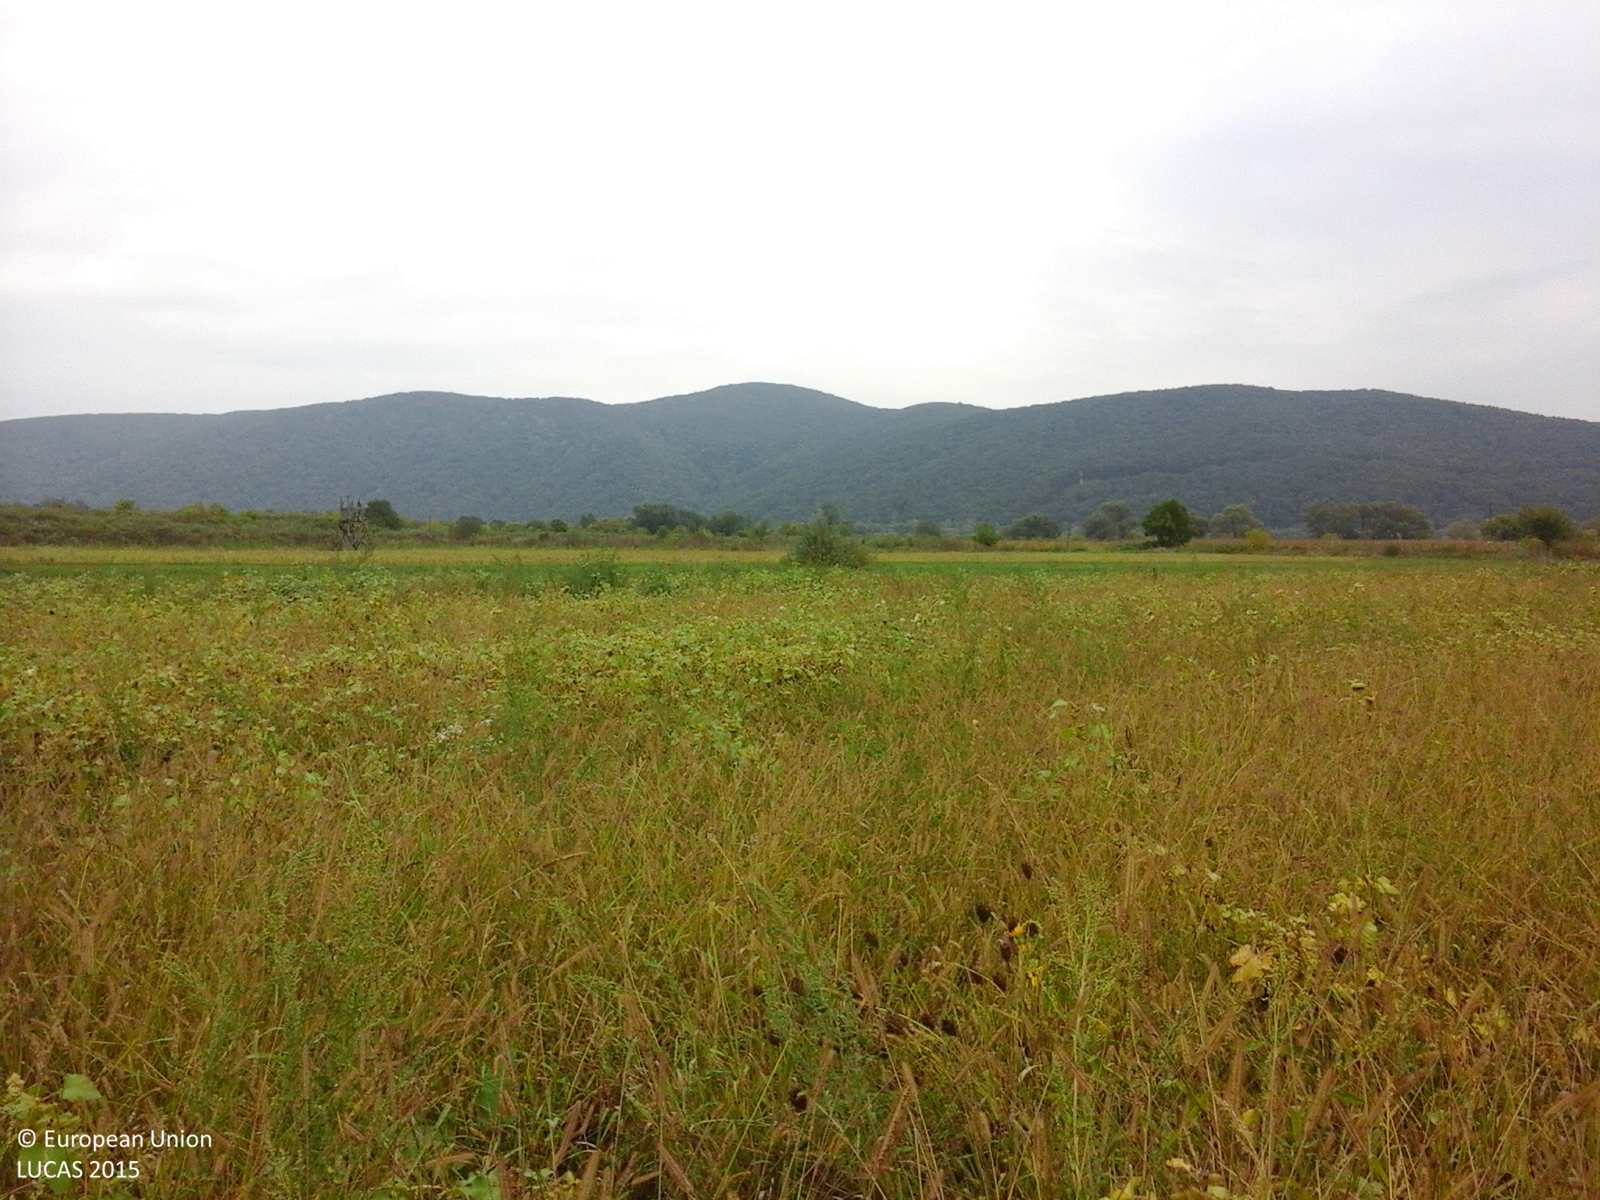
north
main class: Grassland
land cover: Spontaneously vegetated surfaces
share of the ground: > 75 %
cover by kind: herbaceous plants 100 %
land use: Fallow land
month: September
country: RO
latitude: 45.9877
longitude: 22.2705
